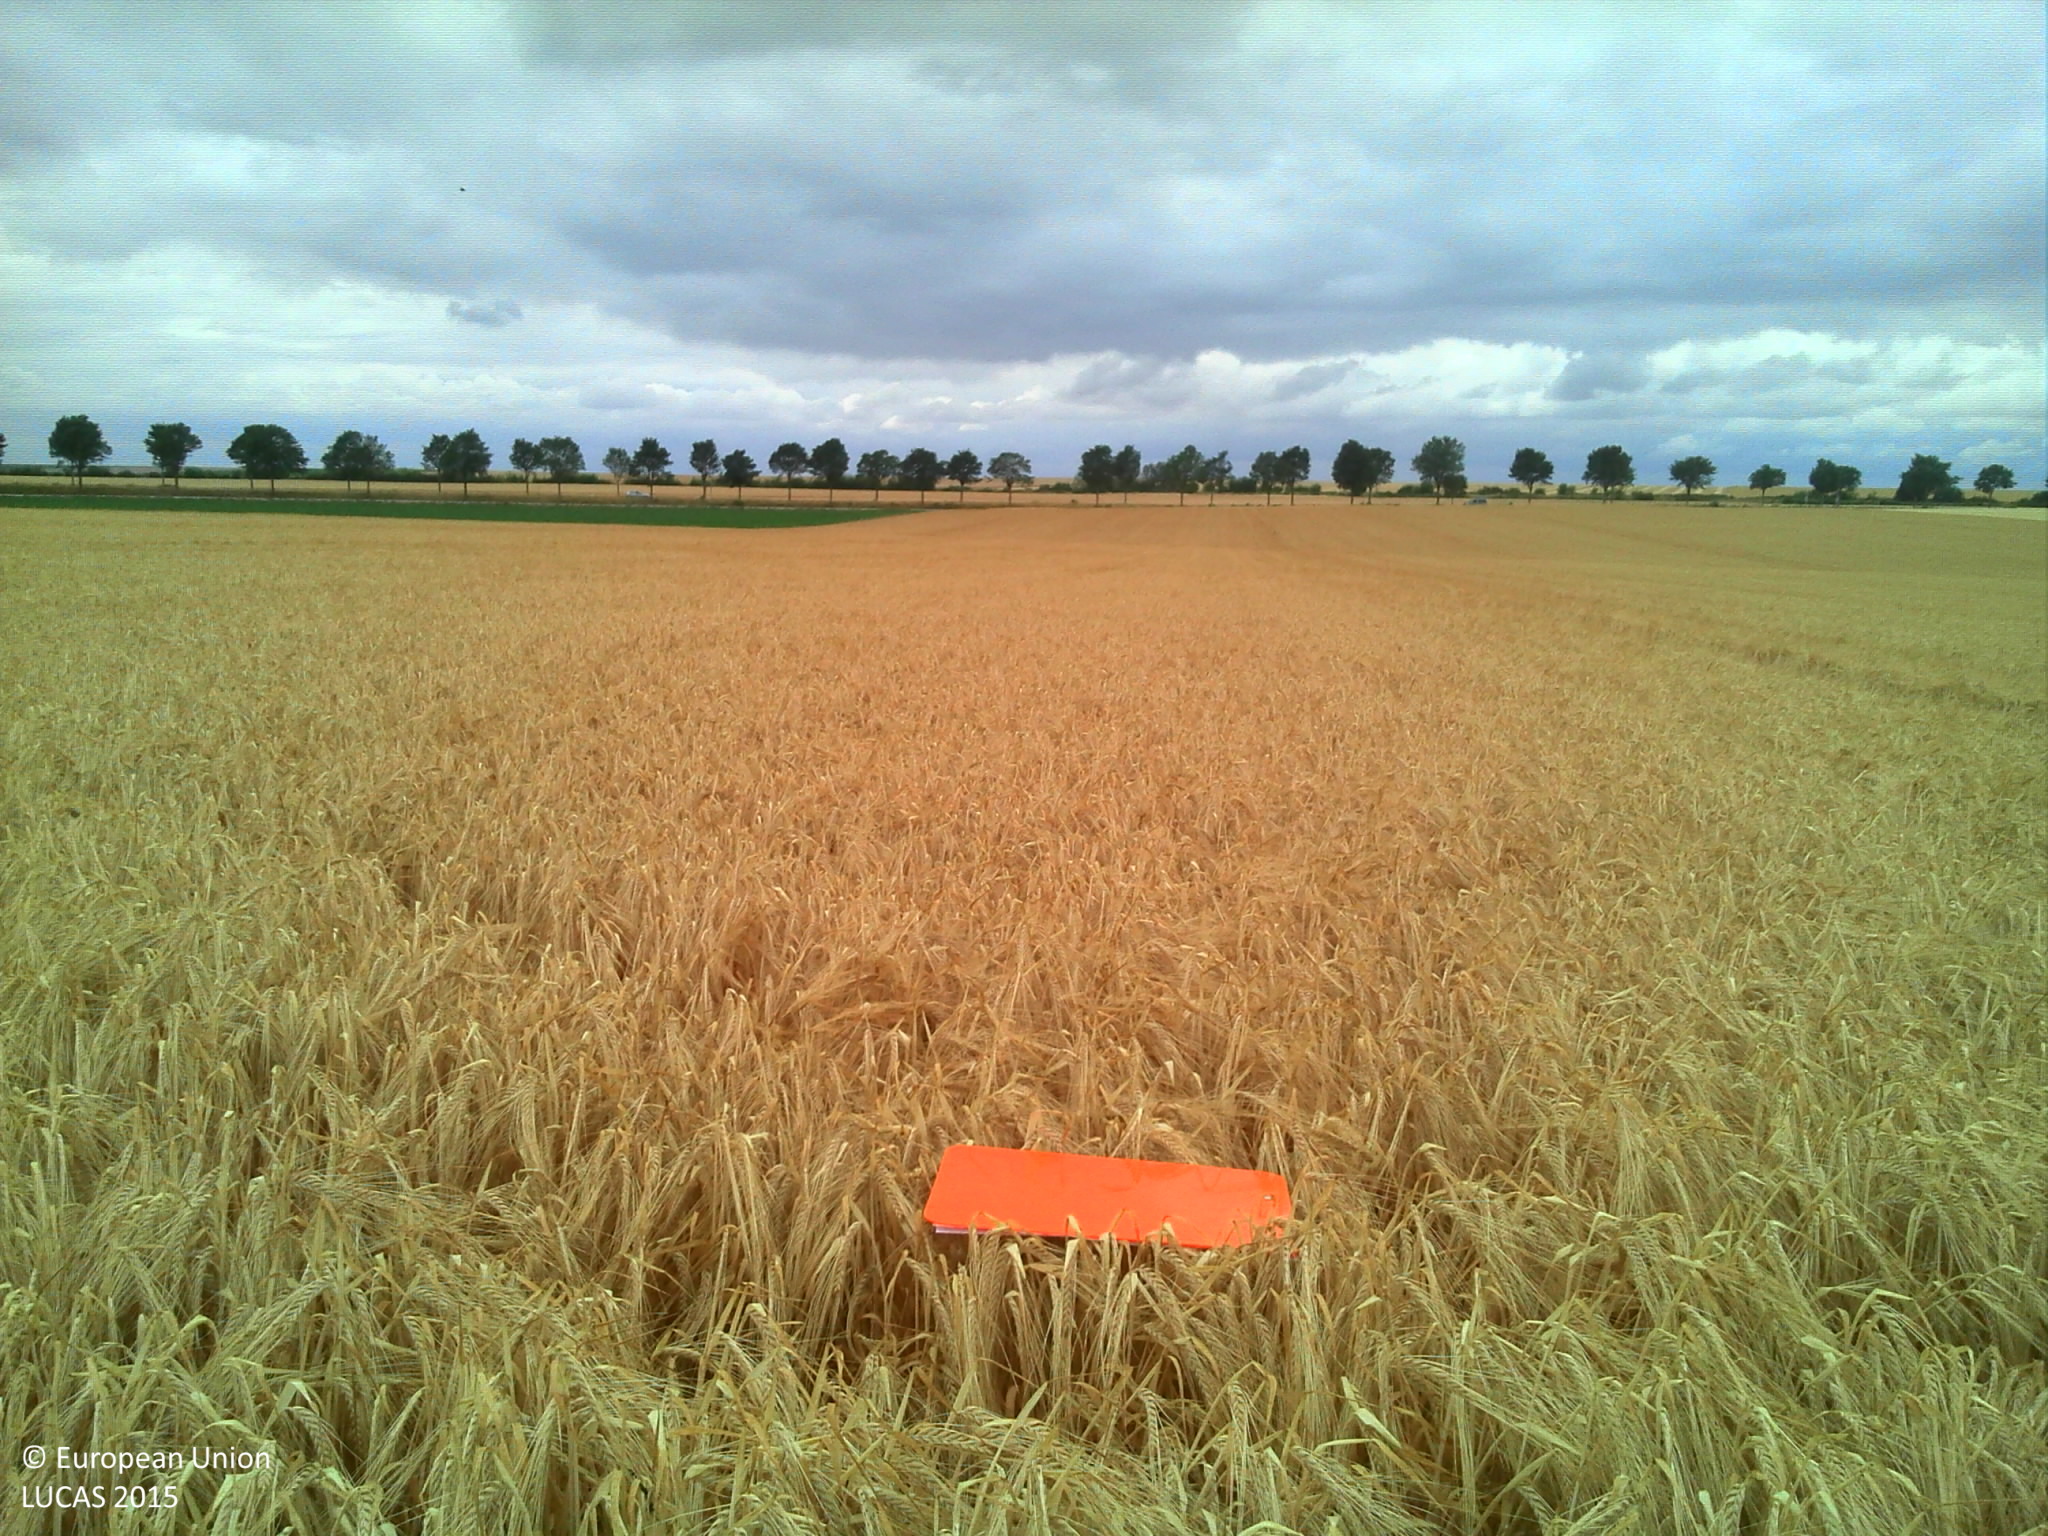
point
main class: Cropland
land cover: Barley
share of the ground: > 75 %
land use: Agriculture (excluding fallow land and kitchen gardens)
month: July
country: FR
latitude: 48.7571
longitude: 4.2149
